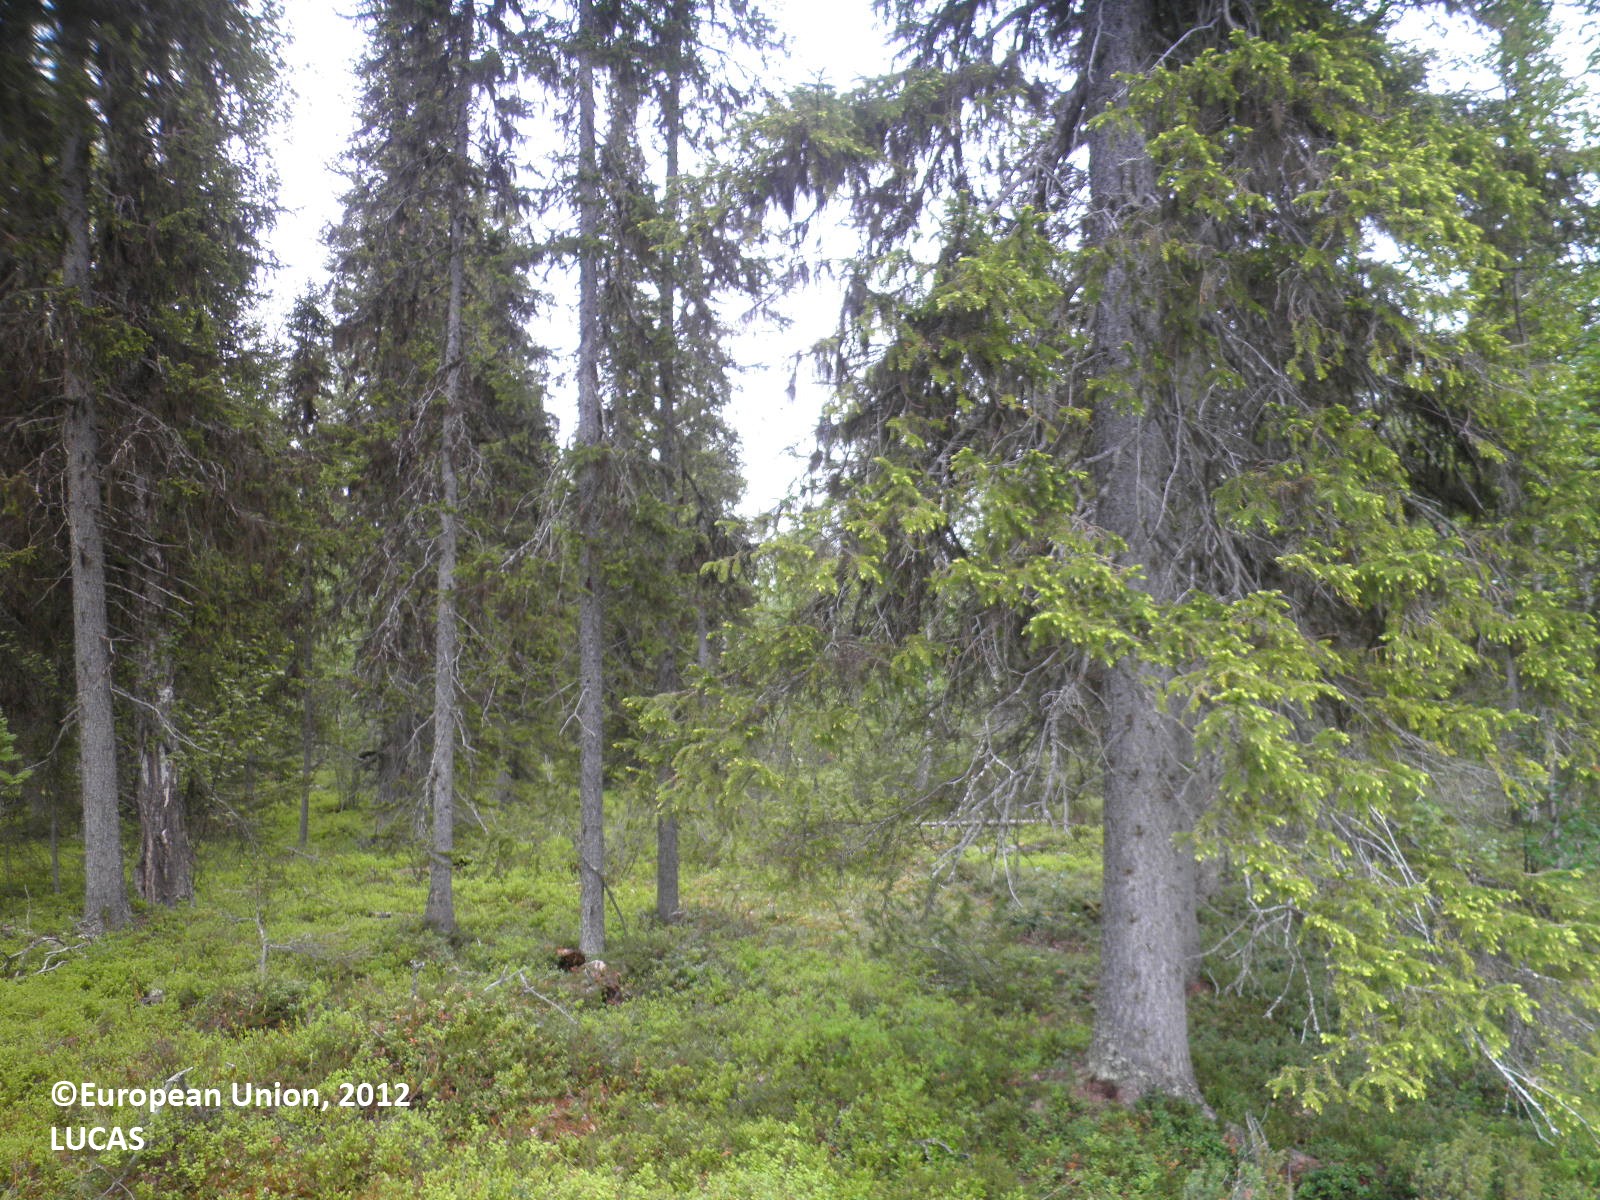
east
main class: Woodland
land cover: Spruce dominated mixed woodland
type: boreal forest
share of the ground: 25 - 50 %
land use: Forestry
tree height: > 5 m
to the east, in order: Spruce dominated mixed woodland; Pine dominated coniferous woodland; Spruce dominated coniferous woodland
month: June
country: FI
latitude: 67.8191
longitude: 25.6897
